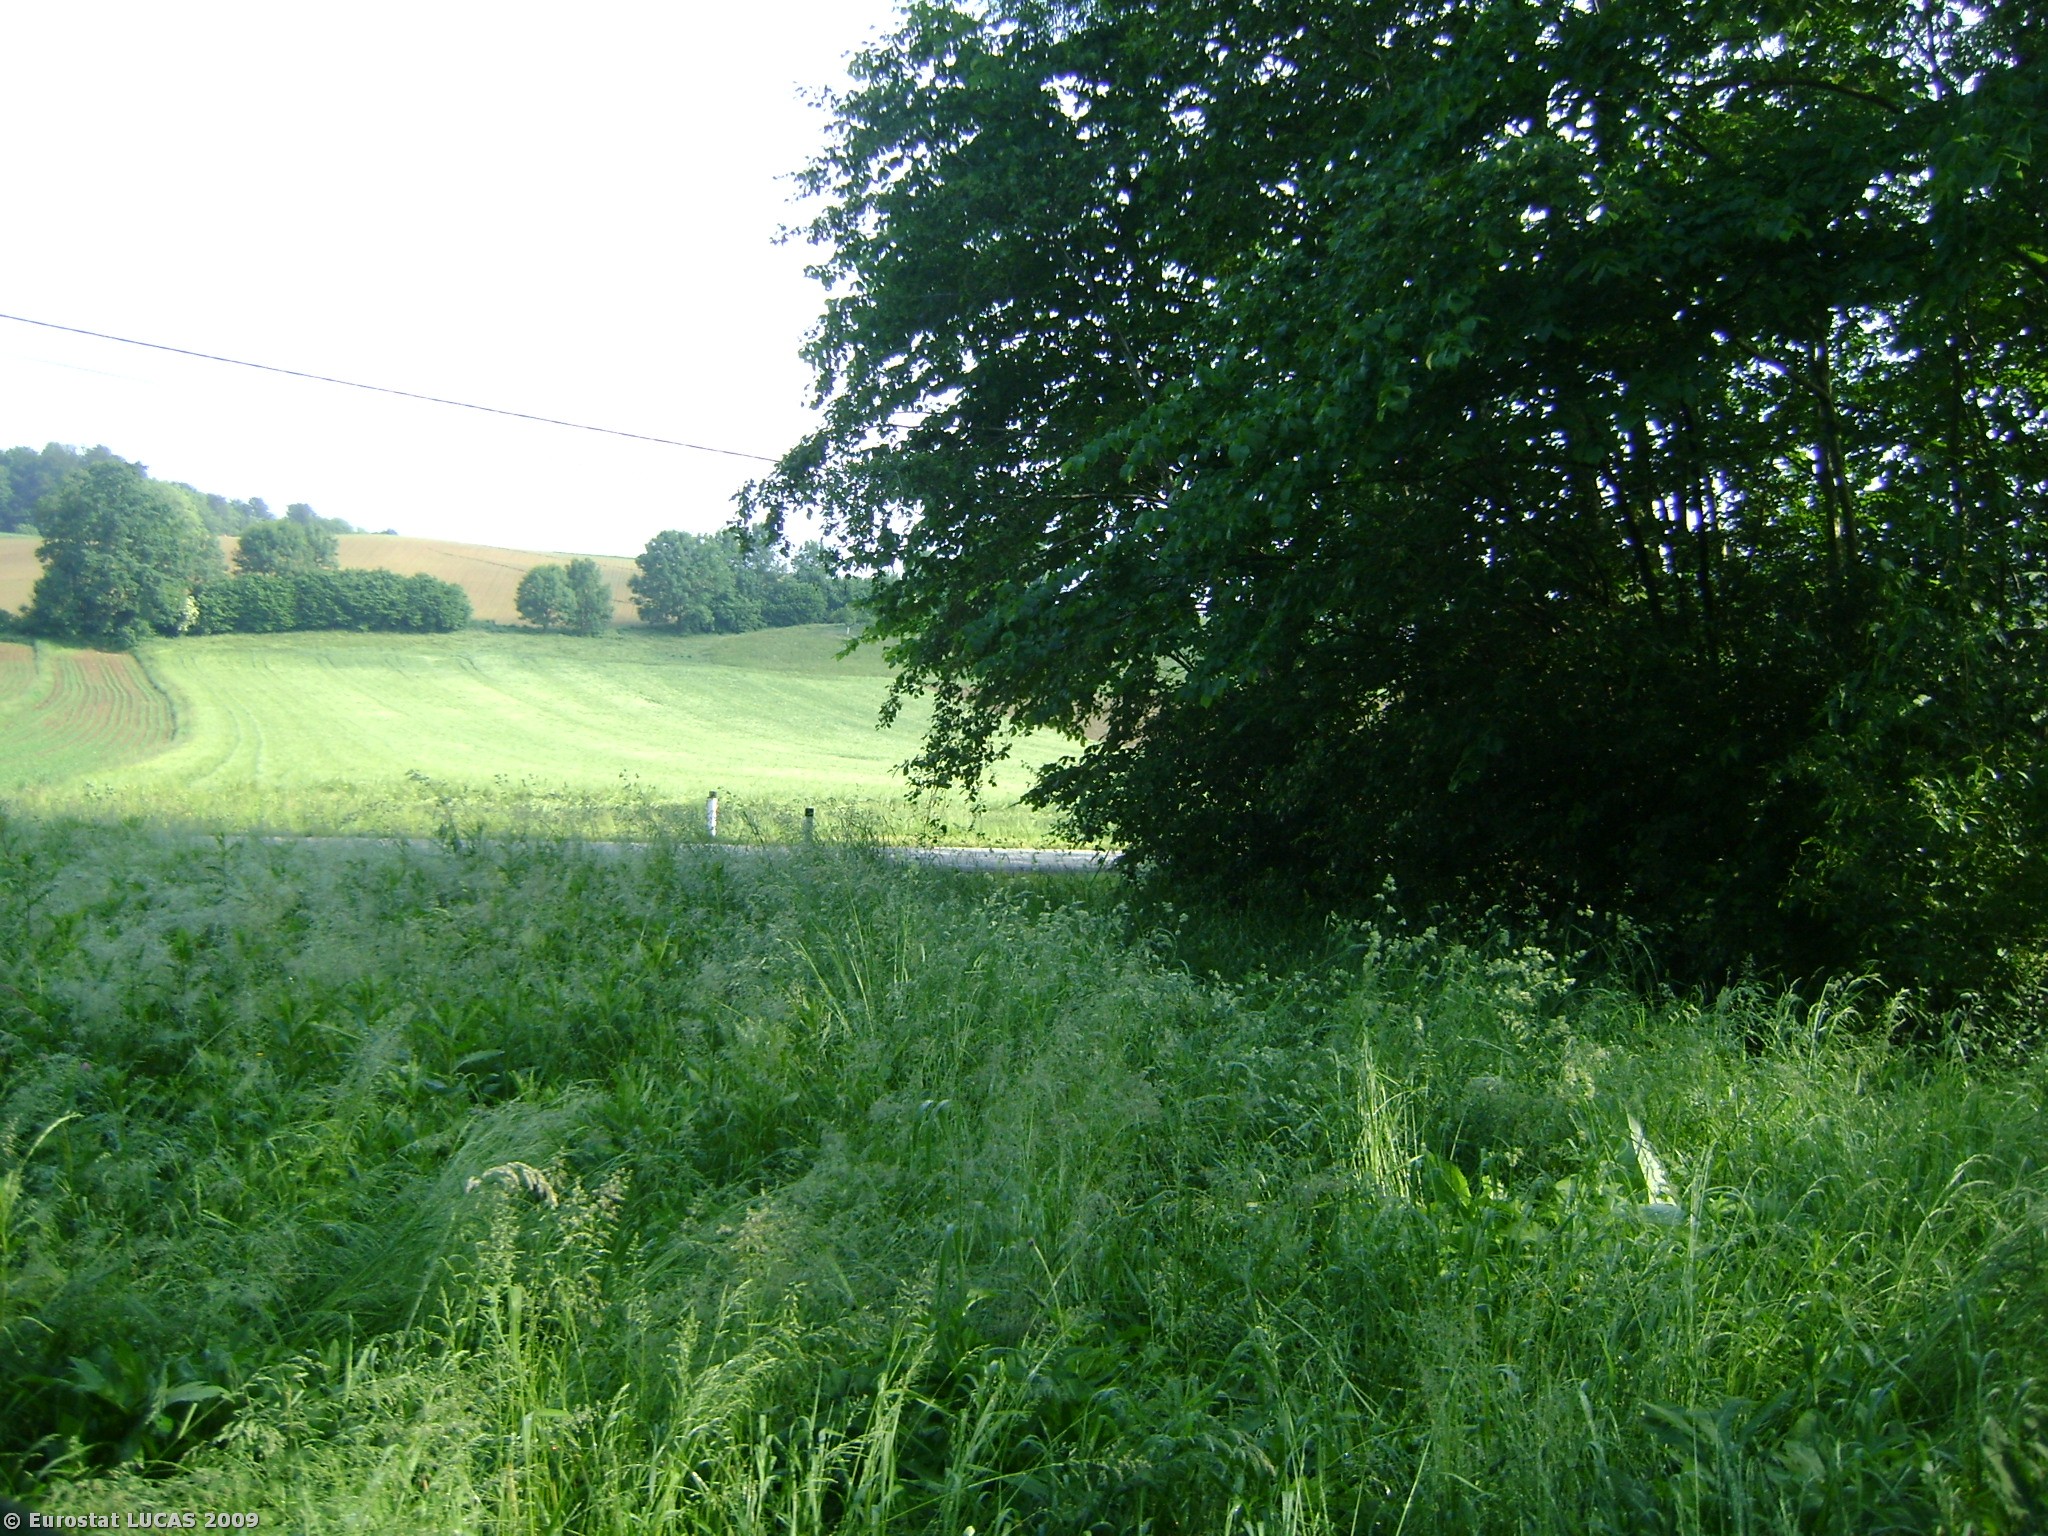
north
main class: Grassland
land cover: Grassland without tree/shrub cover
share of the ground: > 75 %
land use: Agriculture (excluding fallow land and kitchen gardens)
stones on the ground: < 10 %
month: May
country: AT
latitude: 46.7493
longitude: 15.5365
